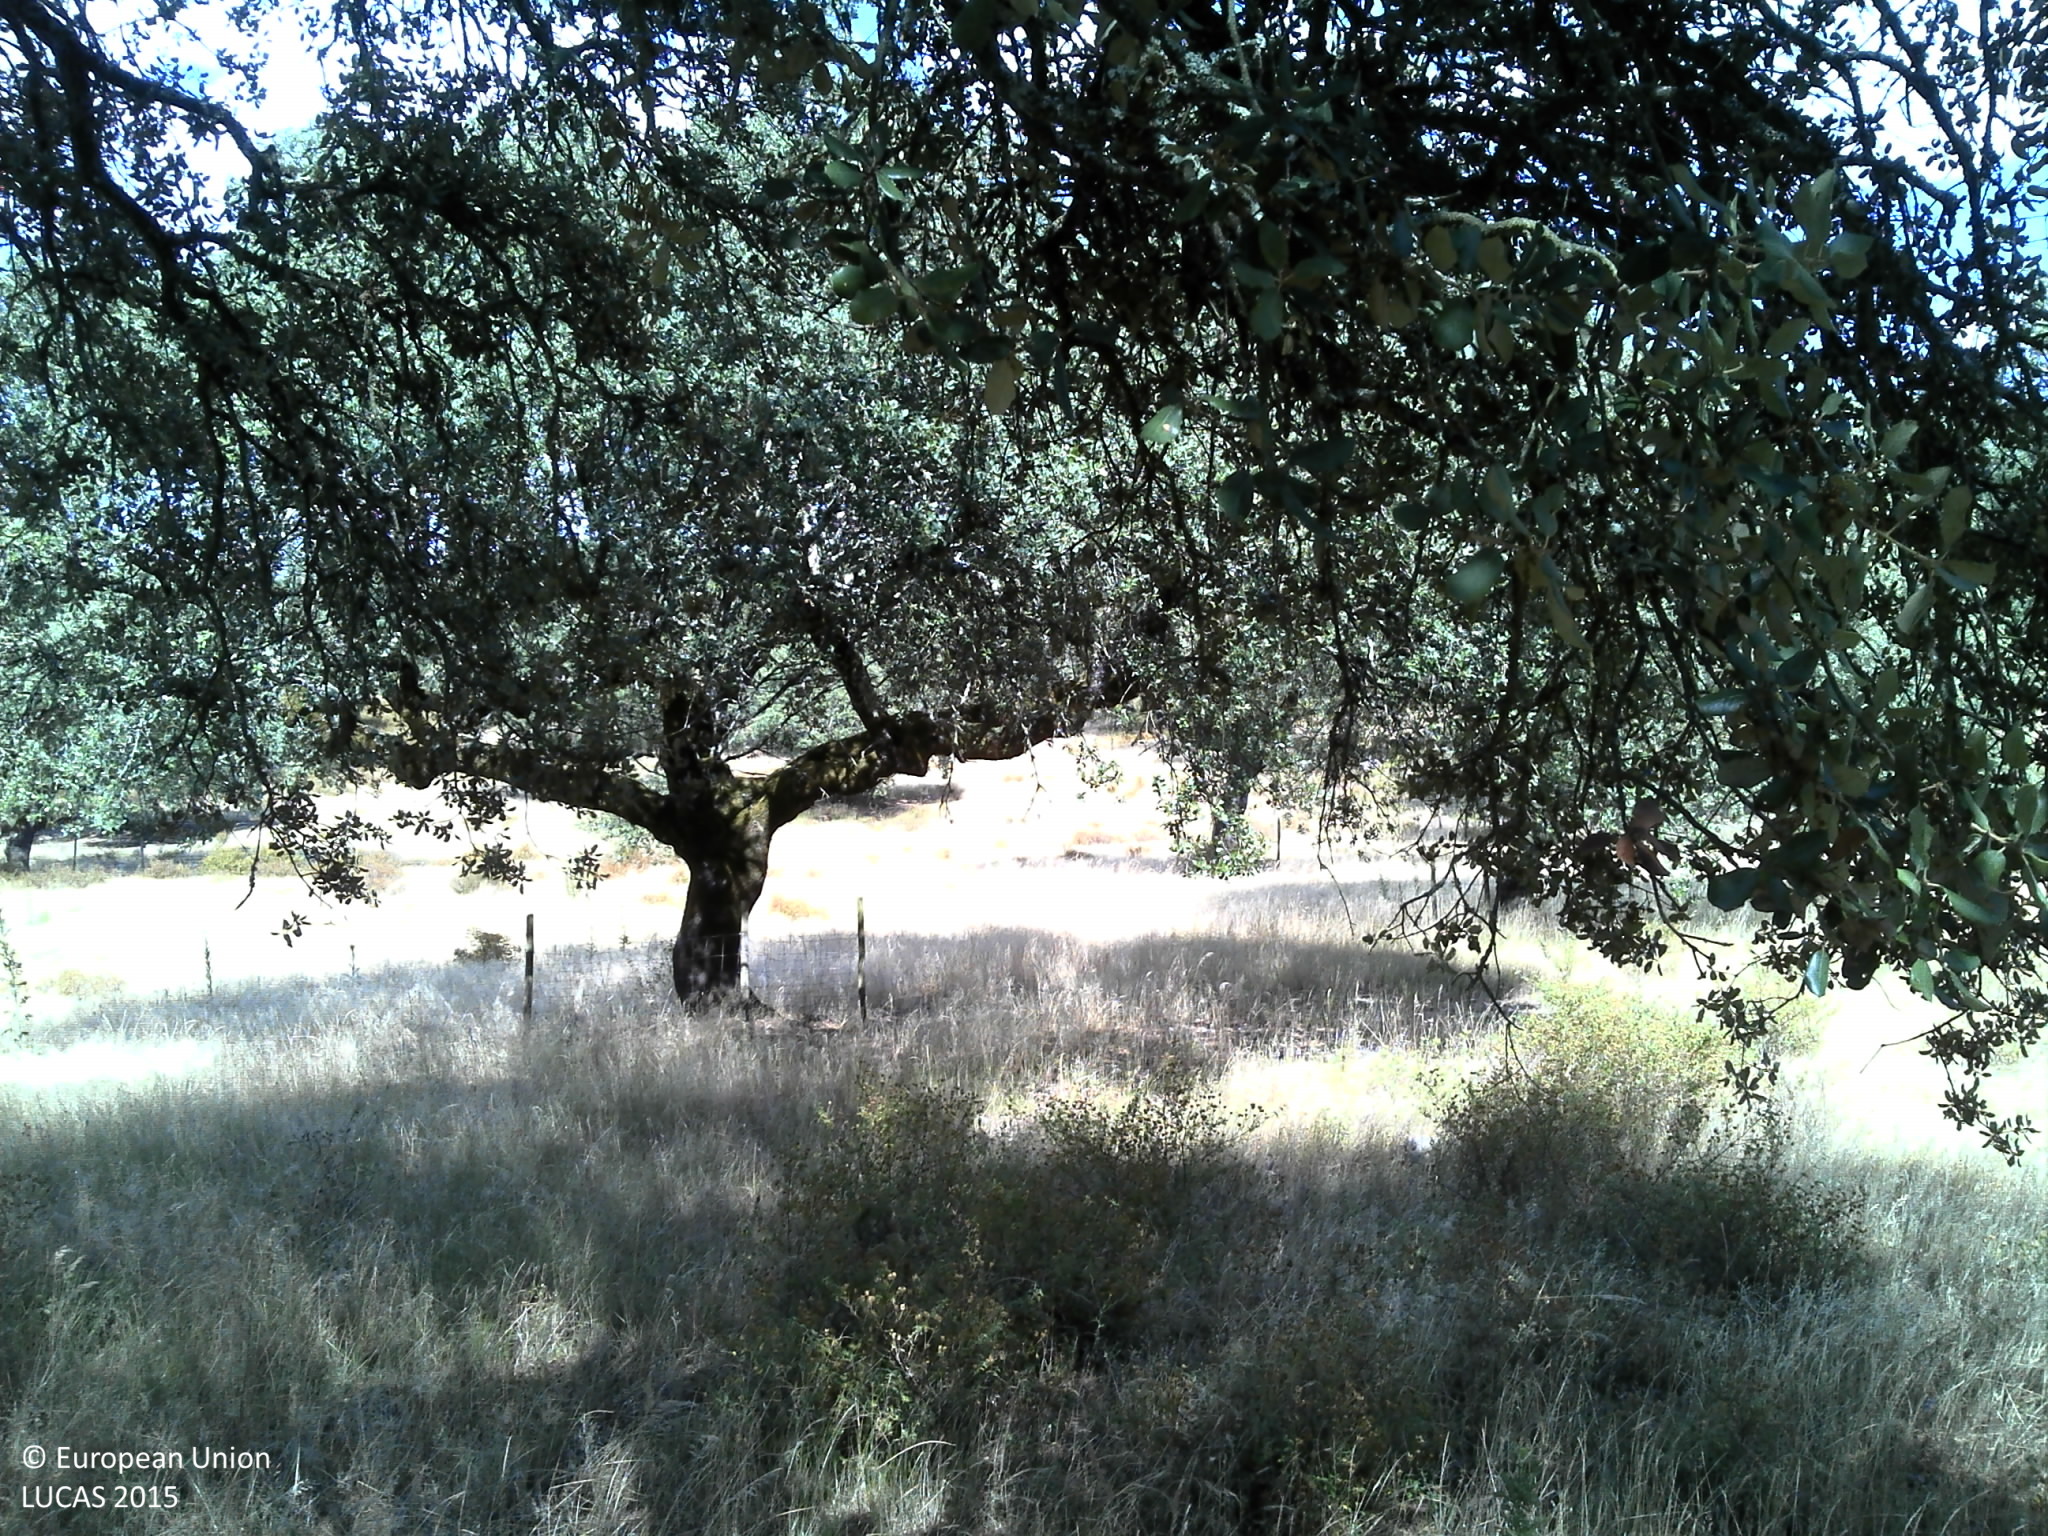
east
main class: Woodland
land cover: Broadleaved woodland
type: broadleaved evergreen forest
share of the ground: 10 - 25 %
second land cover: Grassland without tree/shrub cover
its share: 10 - 25 %
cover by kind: unconsolidated bare surface 55 %, herbaceous plants 25 %, broadleaved forest trees 15 %, shrubs 5 %
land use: Forestry
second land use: Agriculture (excluding fallow land and kitchen gardens)
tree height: > 5 m
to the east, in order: Broadleaved woodland; Grassland without tree/shrub cover; Broadleaved woodland; Fences; Broadleaved woodland; Fences; Broadleaved woodland; Fences; Broadleaved woodland; Fences; Broadleaved woodland; Fences; Broadleaved woodland; Fences; Broadleaved woodland
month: June
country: PT
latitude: 38.5820
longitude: -8.2194
